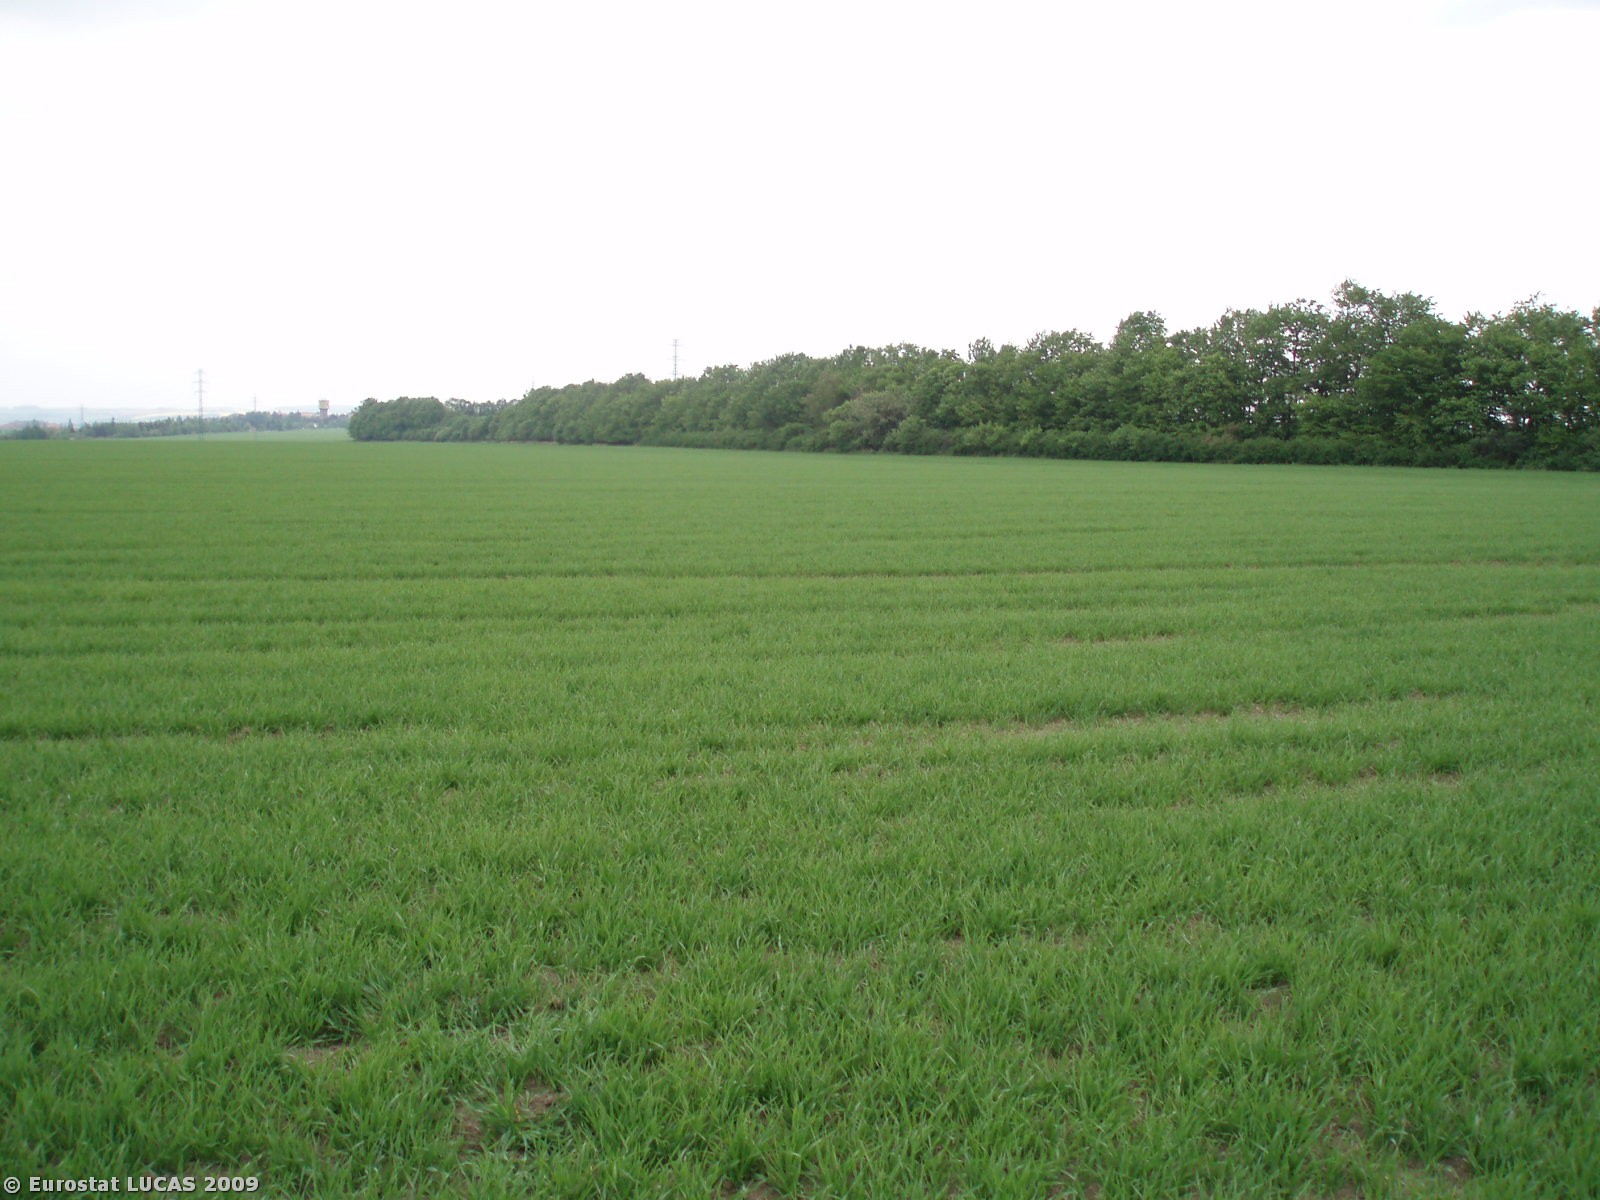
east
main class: Cropland
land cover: Barley
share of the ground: > 75 %
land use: Agriculture (excluding fallow land and kitchen gardens)
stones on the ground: < 10 %
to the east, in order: Barley; Abandoned hedges; Broadleaved woodland; Barley
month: May
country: CZ
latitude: 50.1445
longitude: 14.1571
